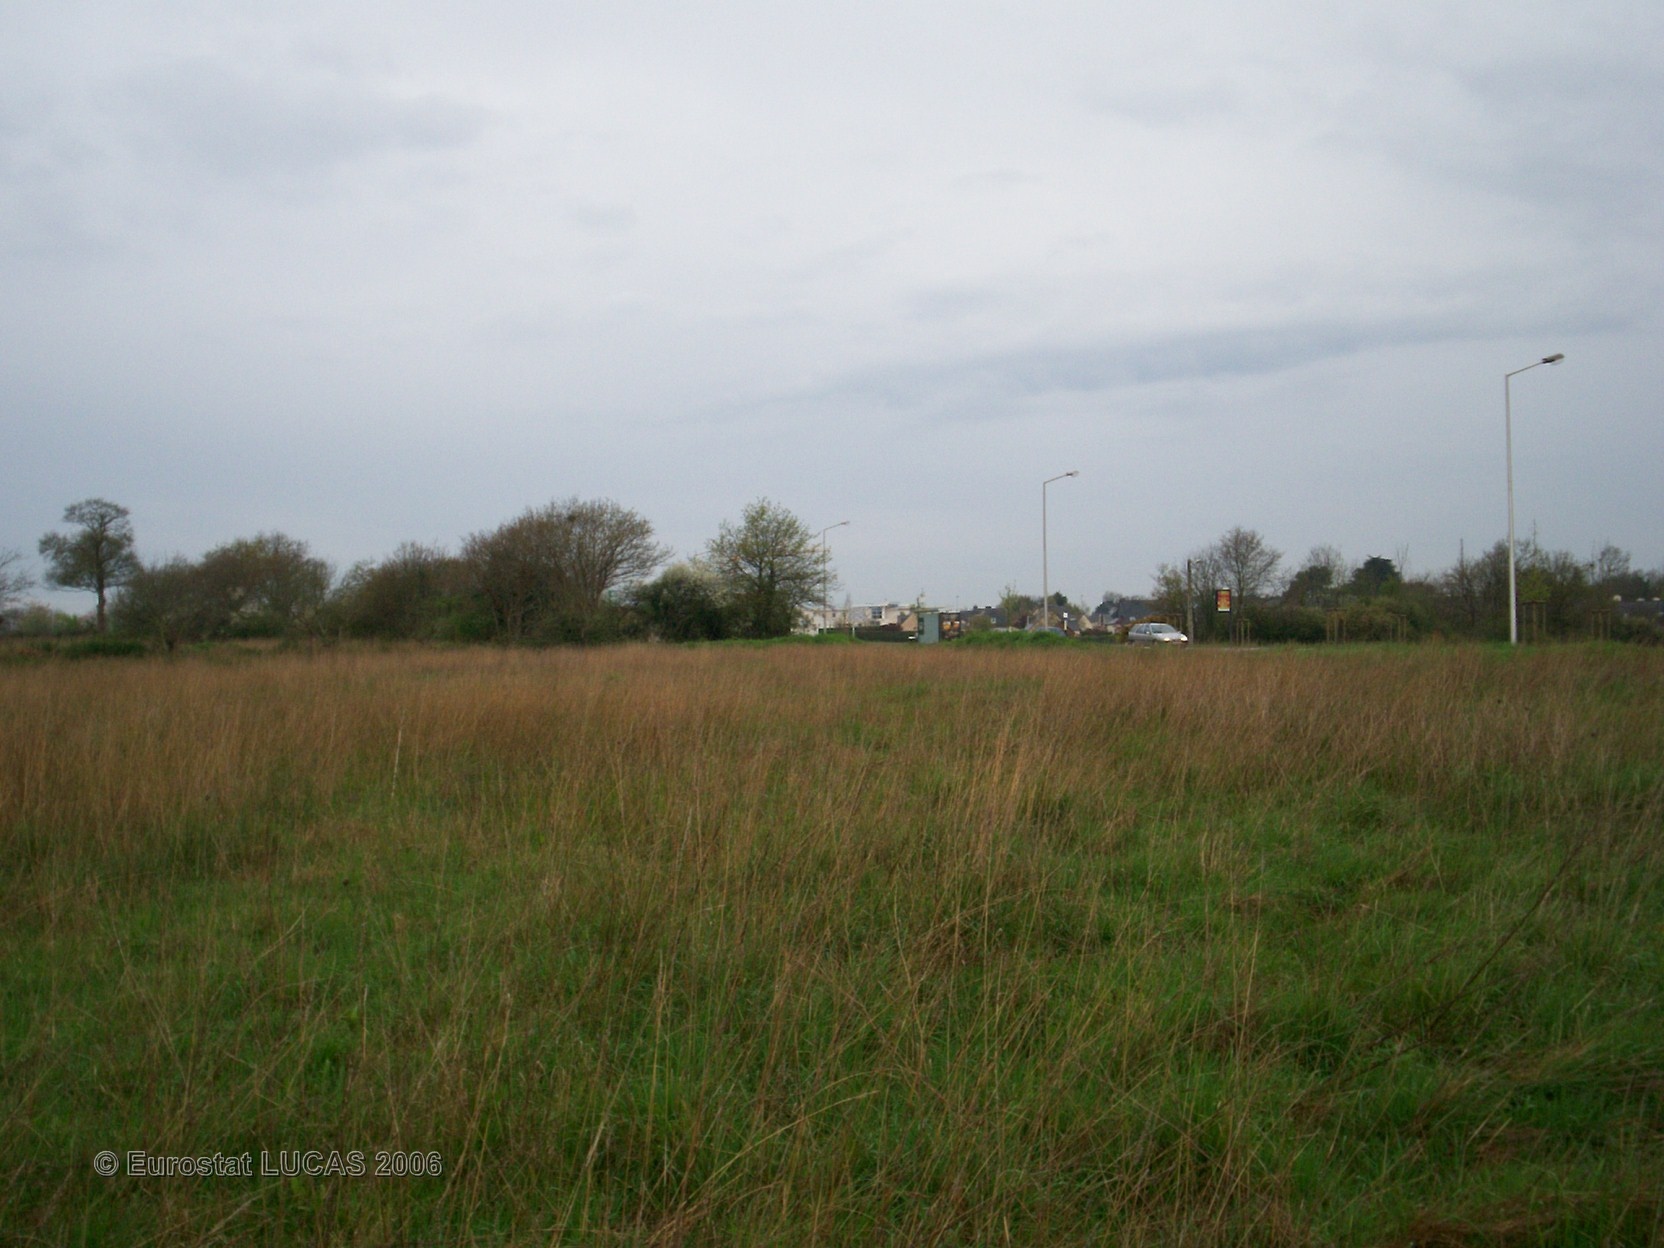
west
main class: Grassland
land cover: Grassland without tree/shrub cover
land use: Agriculture (excluding fallow land and kitchen gardens)
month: April
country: FR
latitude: 47.6438
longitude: -2.7475
